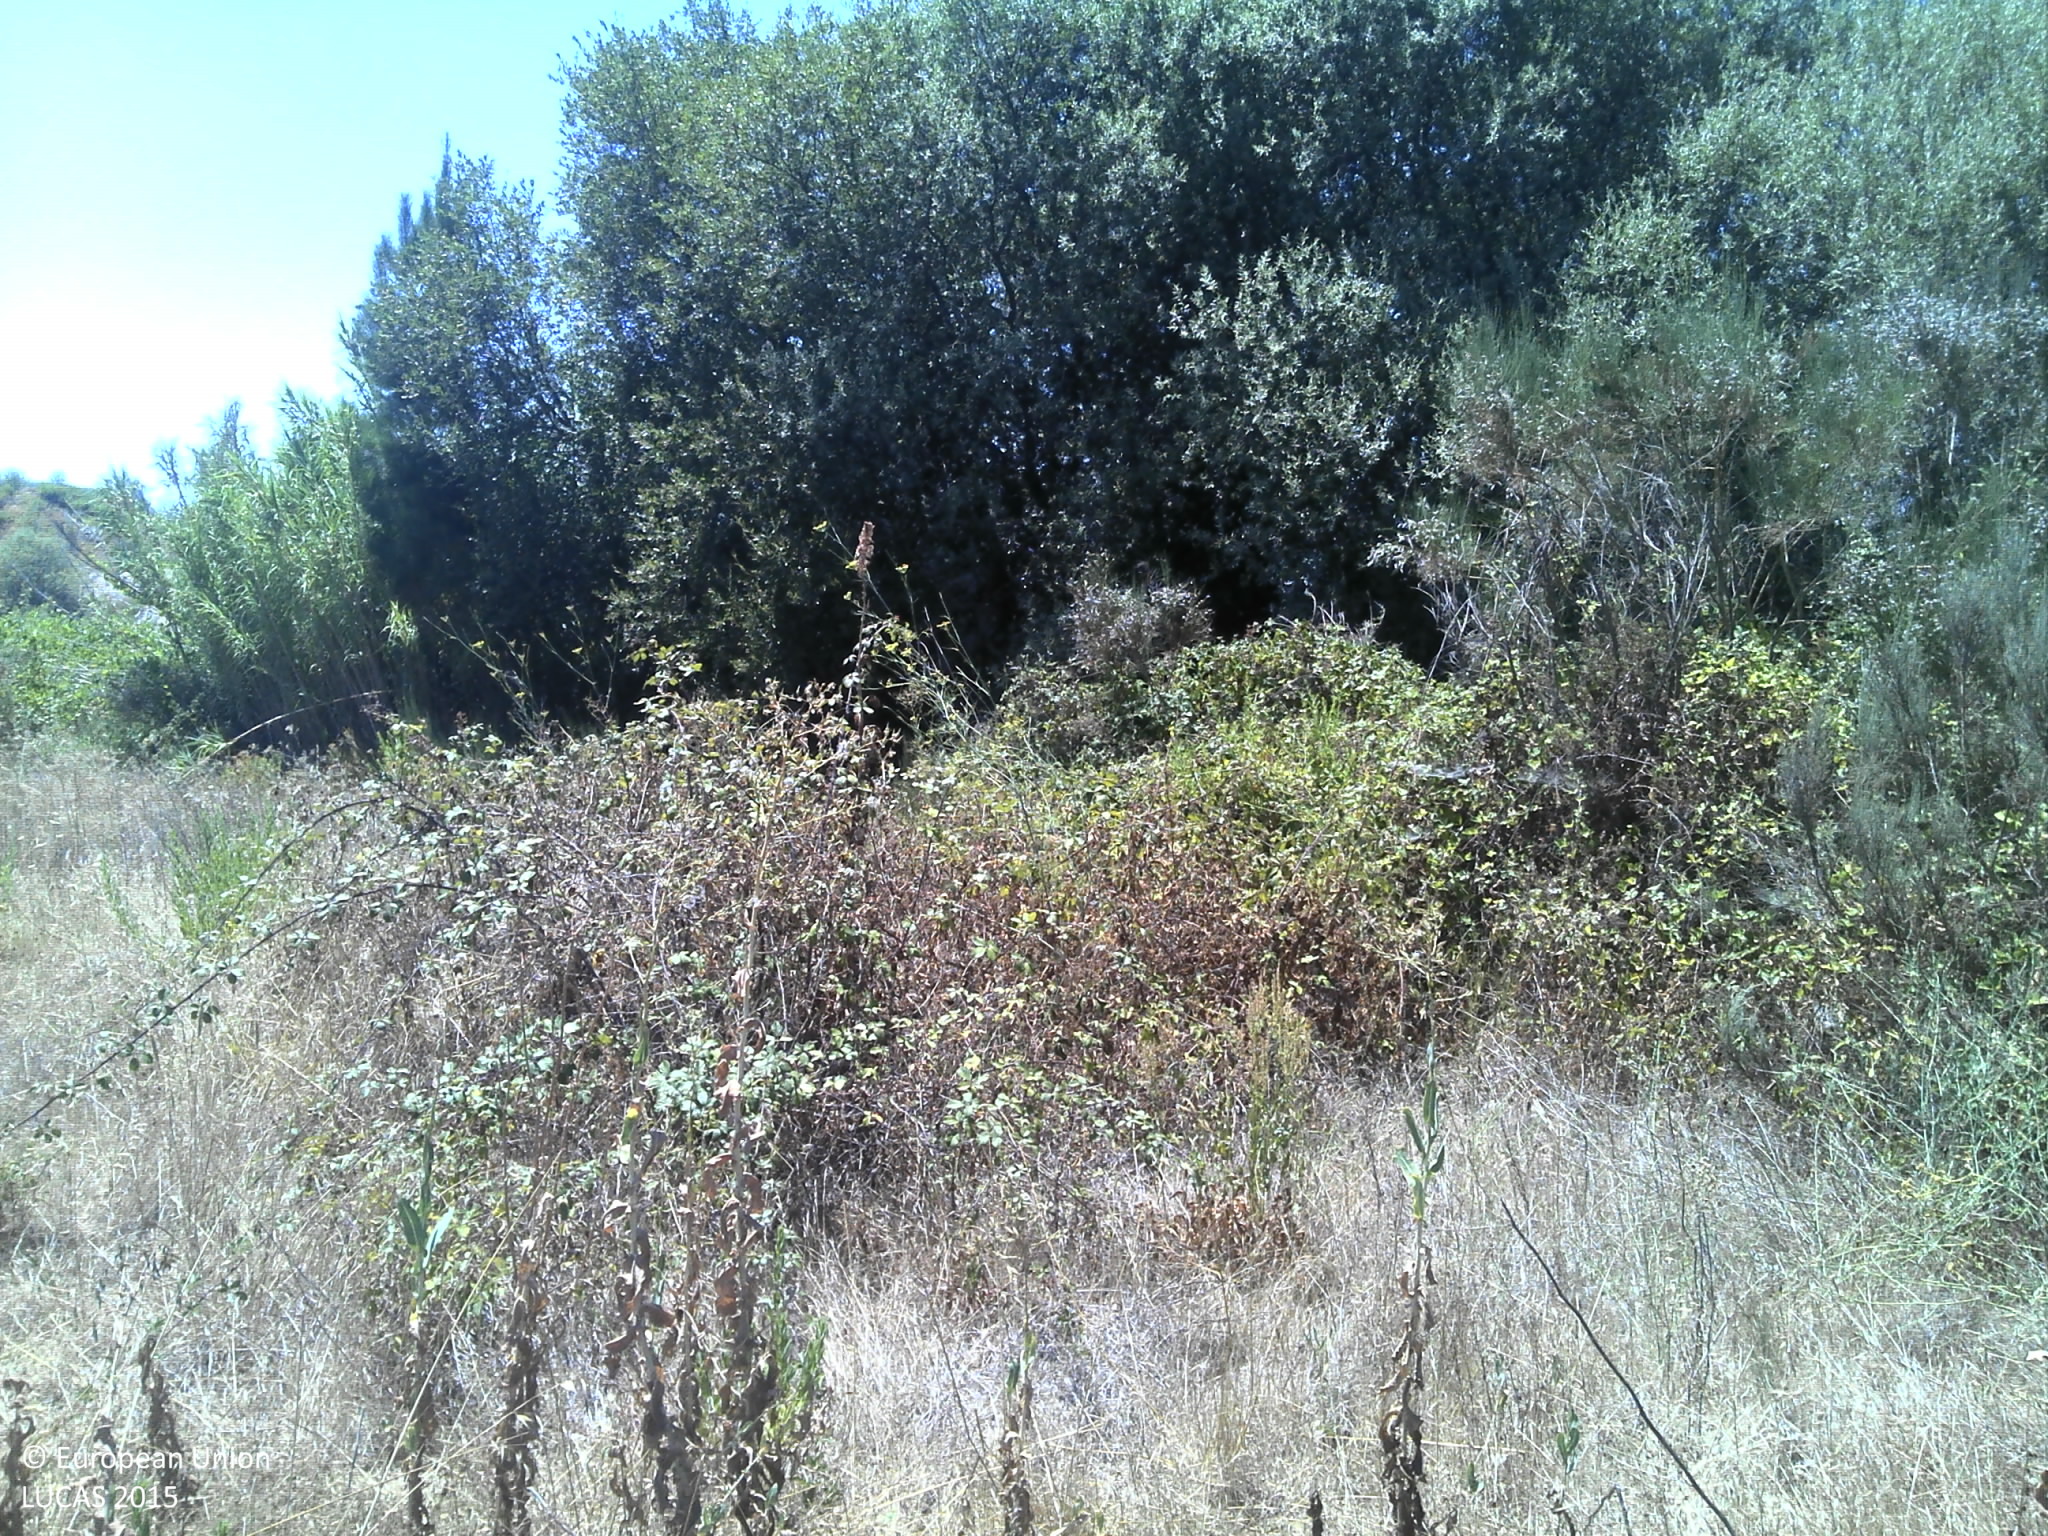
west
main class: Shrubland
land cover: Shrubland without tree cover
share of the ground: > 75 %
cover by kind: shrubs 80 %, herbaceous plants 10 %, unconsolidated bare surface 5 %
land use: Abandoned areas
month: July
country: PT
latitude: 40.4066
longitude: -7.3447
